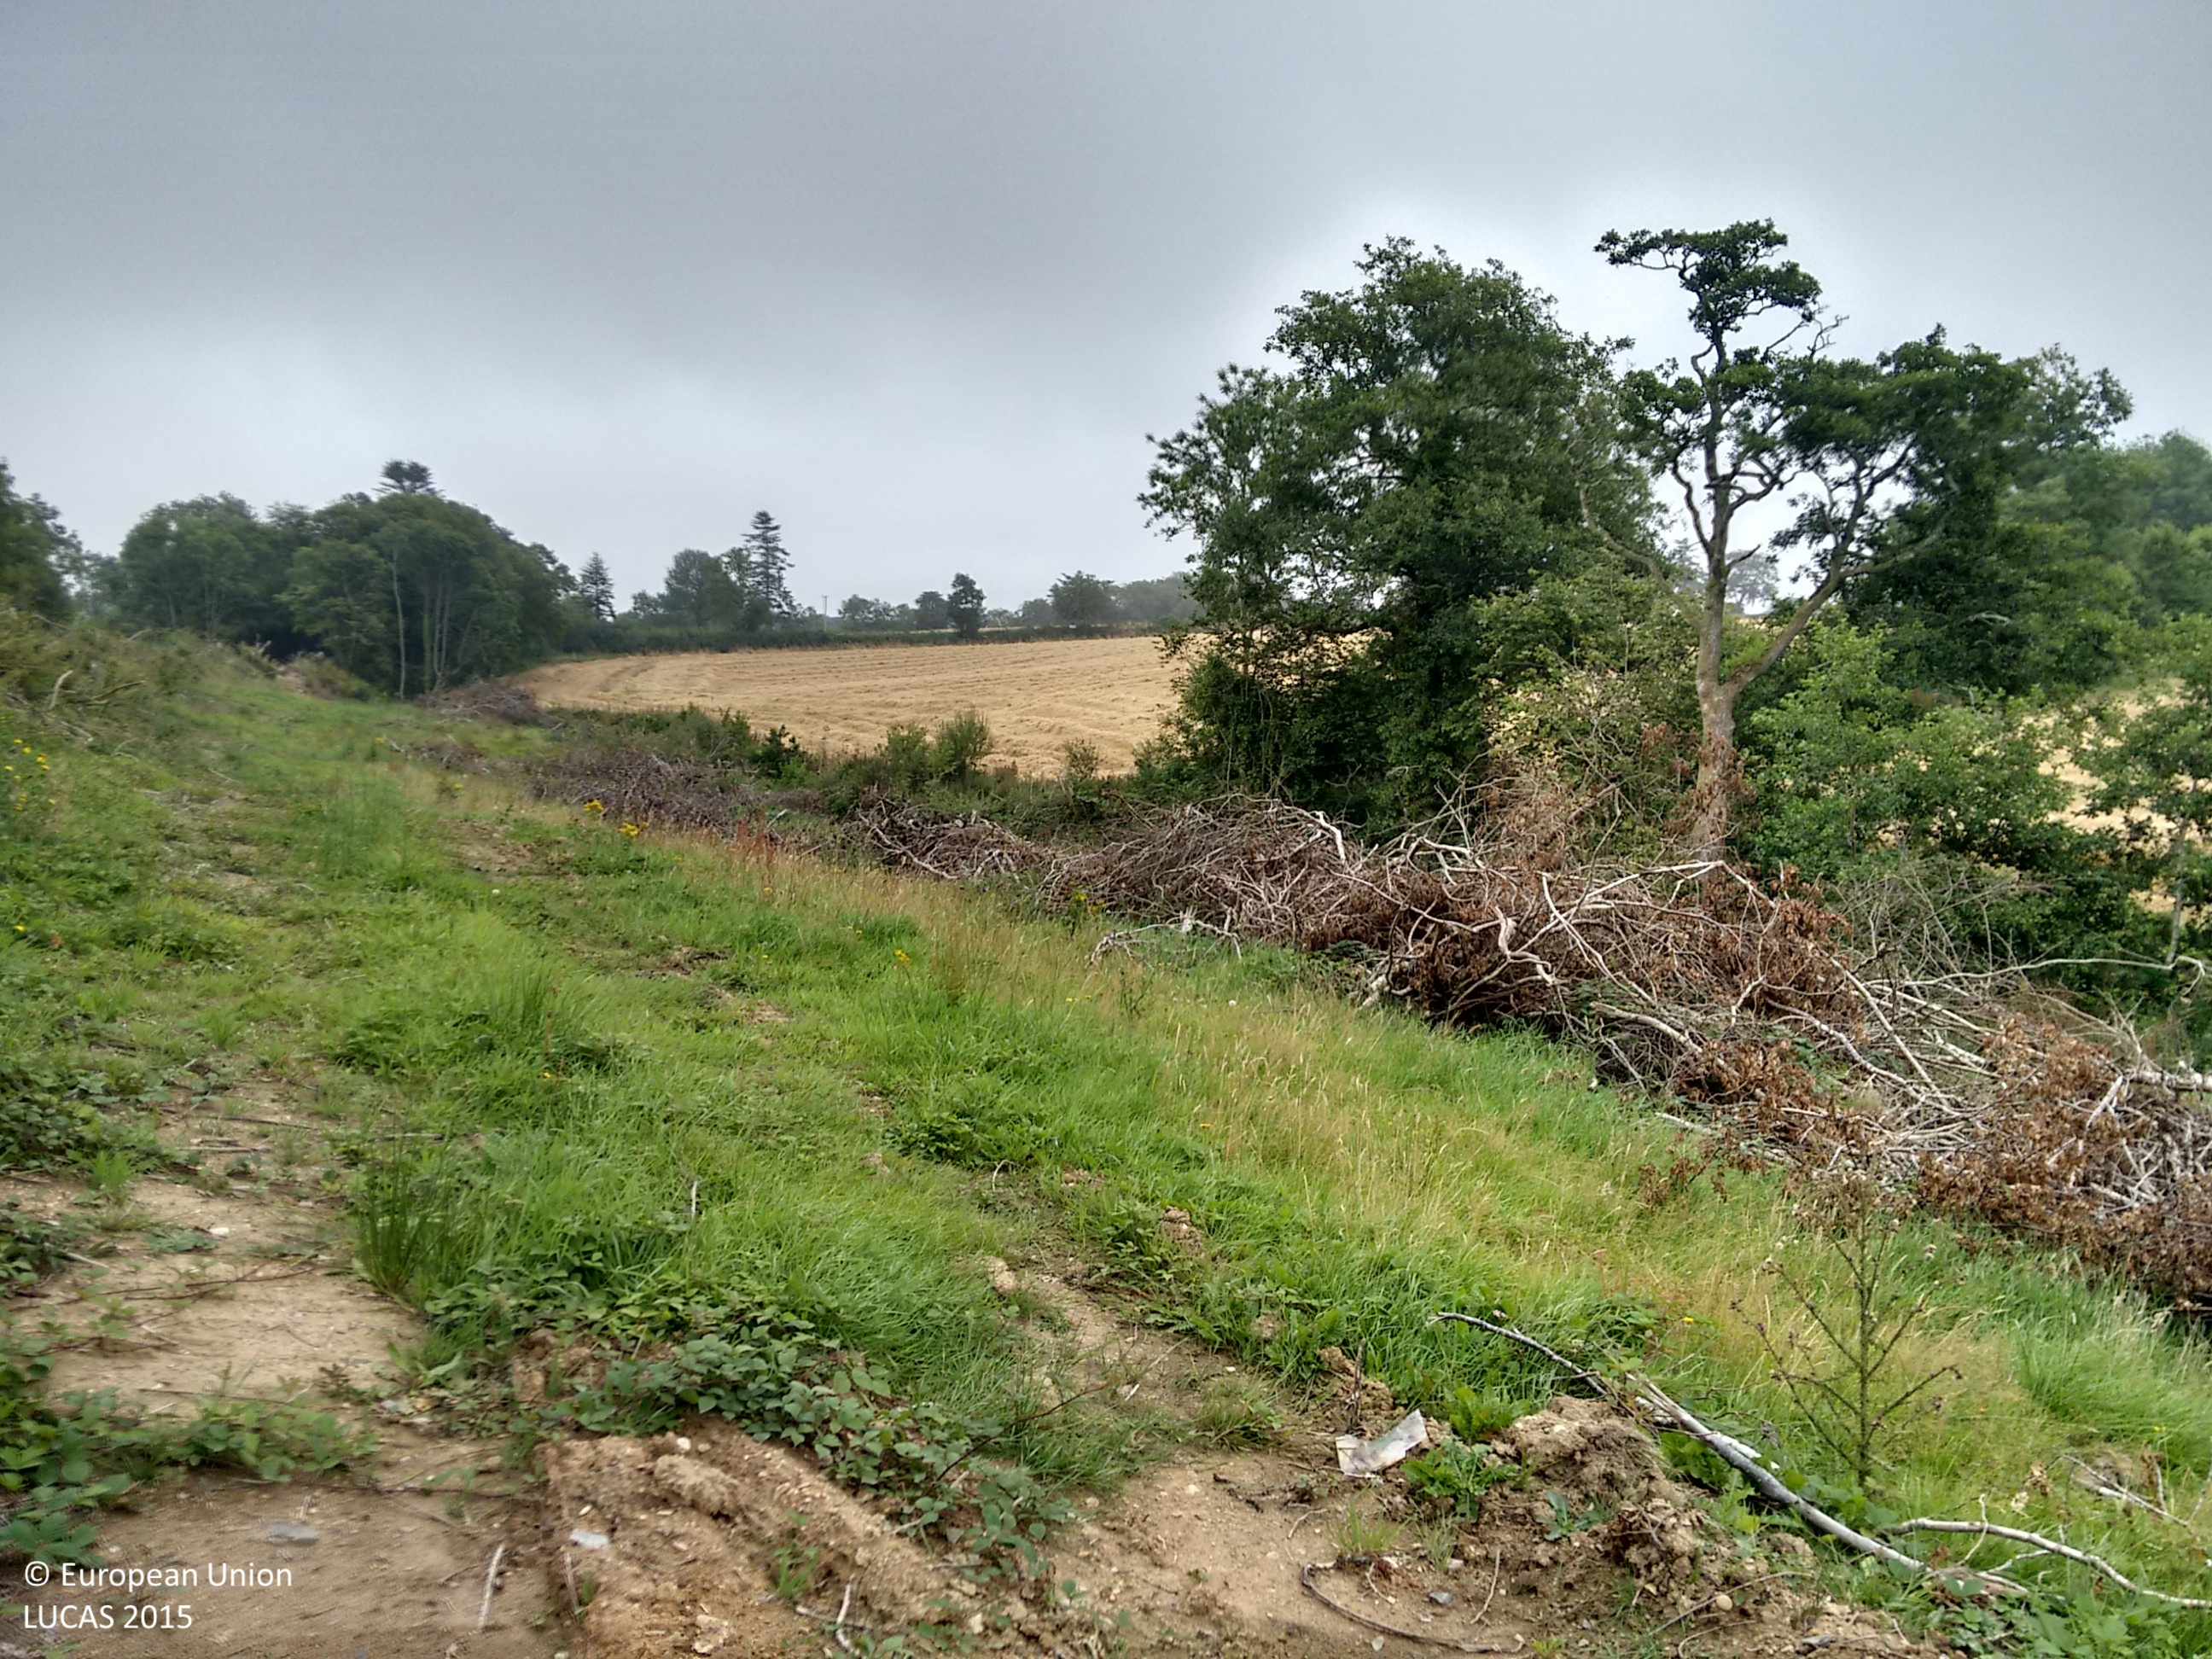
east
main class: Cropland
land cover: Barley
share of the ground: > 75 %
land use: Agriculture (excluding fallow land and kitchen gardens)
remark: Harvested field
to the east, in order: Barley; Abandoned hedges; Barley; Broadleaved woodland; Barley
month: August
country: IE
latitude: 52.4554
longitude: -6.5371
